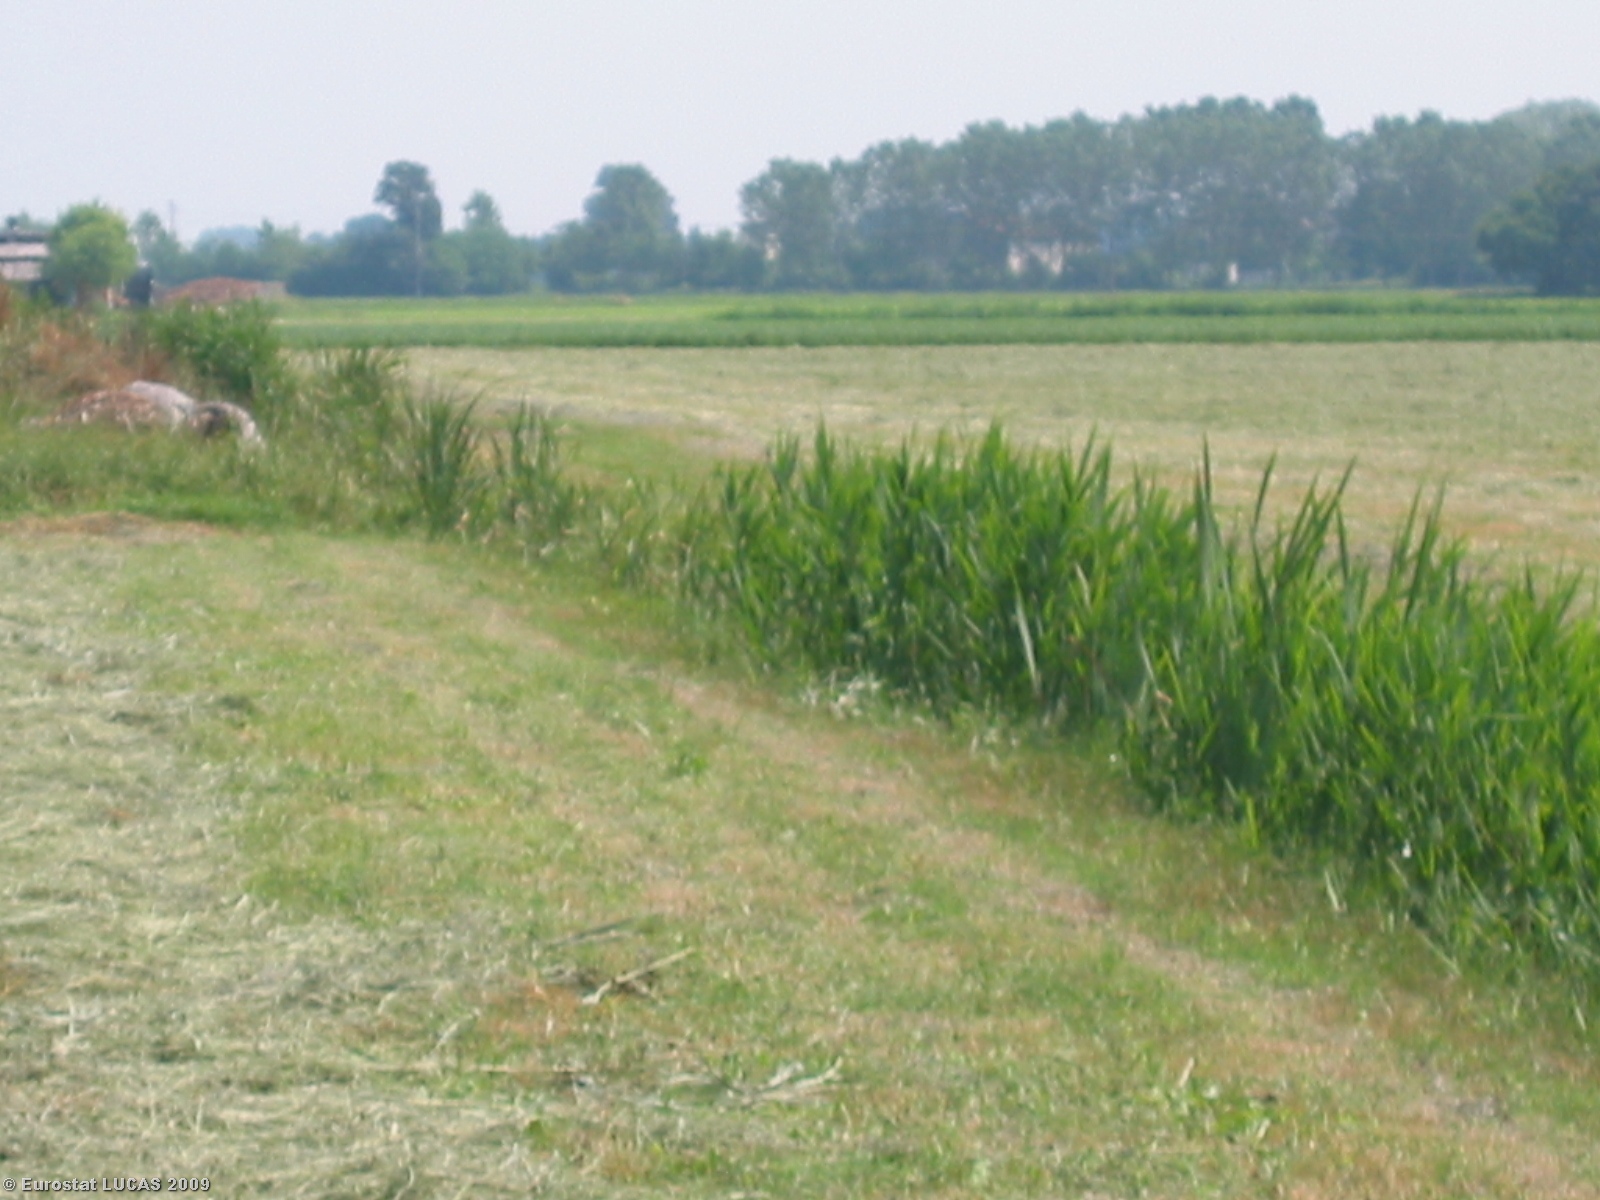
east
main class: Cropland
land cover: Lucerne
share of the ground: > 75 %
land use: Agriculture (excluding fallow land and kitchen gardens)
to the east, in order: Lucerne; Ditches and canals; Tracks; Lucerne; Ditches and canals; Lucerne
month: June
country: IT
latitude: 44.9067
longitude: 10.7710
